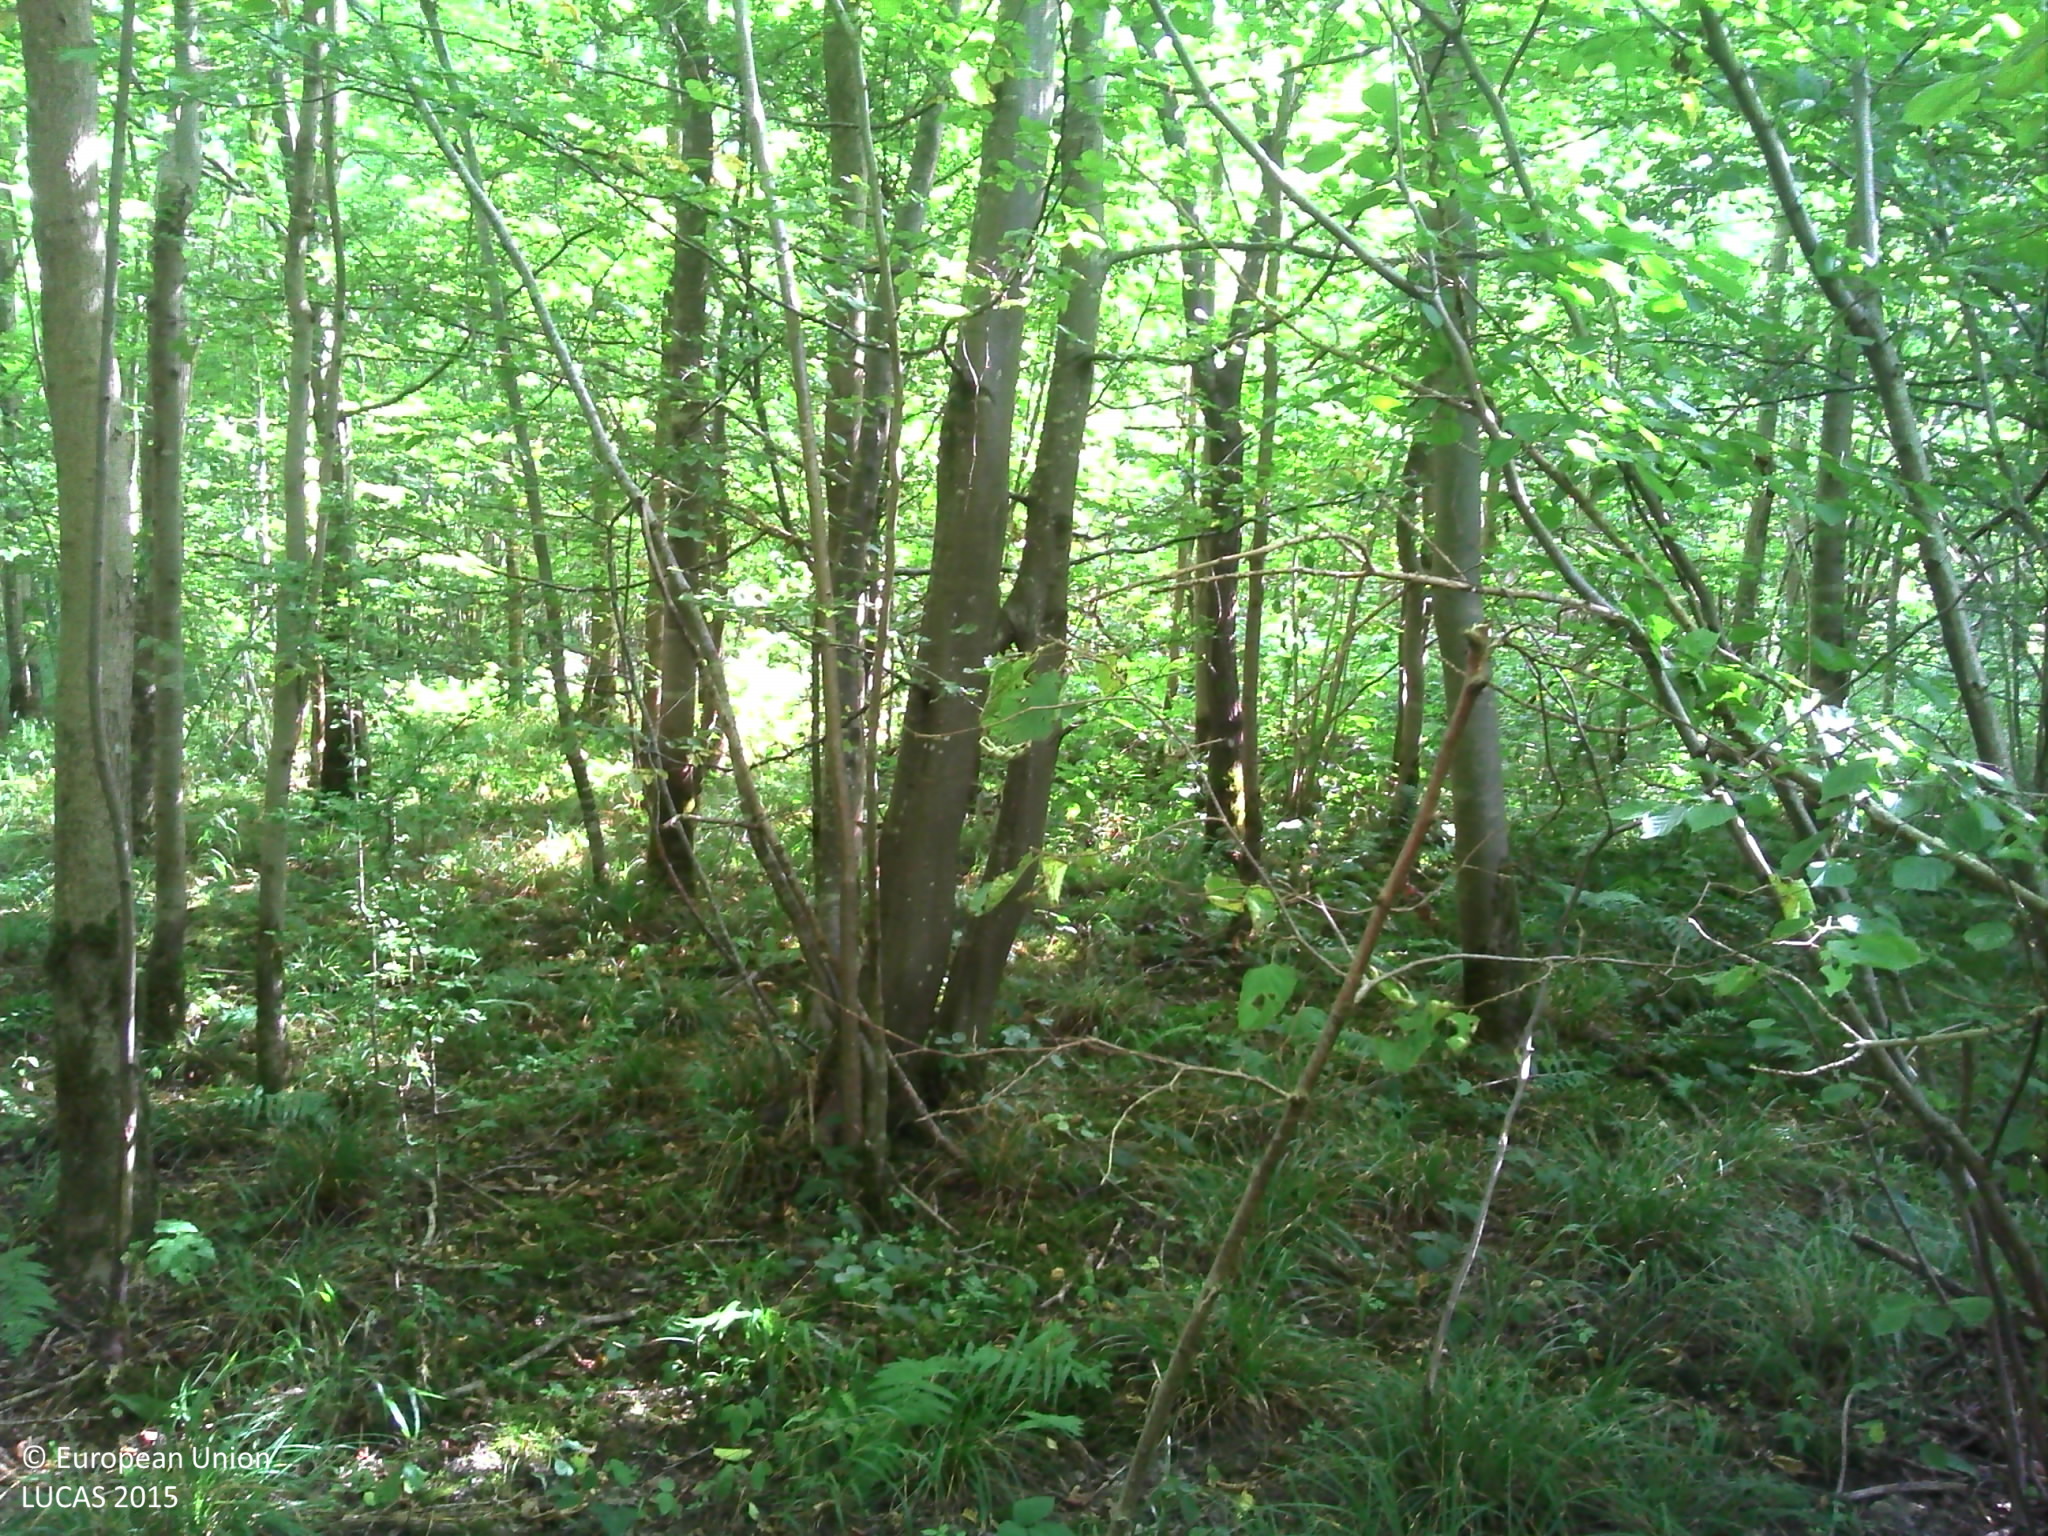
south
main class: Woodland
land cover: Broadleaved woodland
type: mesophytic deciduous forest
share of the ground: > 75 %
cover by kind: broadleaved forest trees 50 %, herbaceous plants 15 %, lichens and mosses 15 %, unconsolidated bare surface 10 %
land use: Forestry
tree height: > 5 m
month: July
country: FR
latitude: 48.7769
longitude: 2.7097
